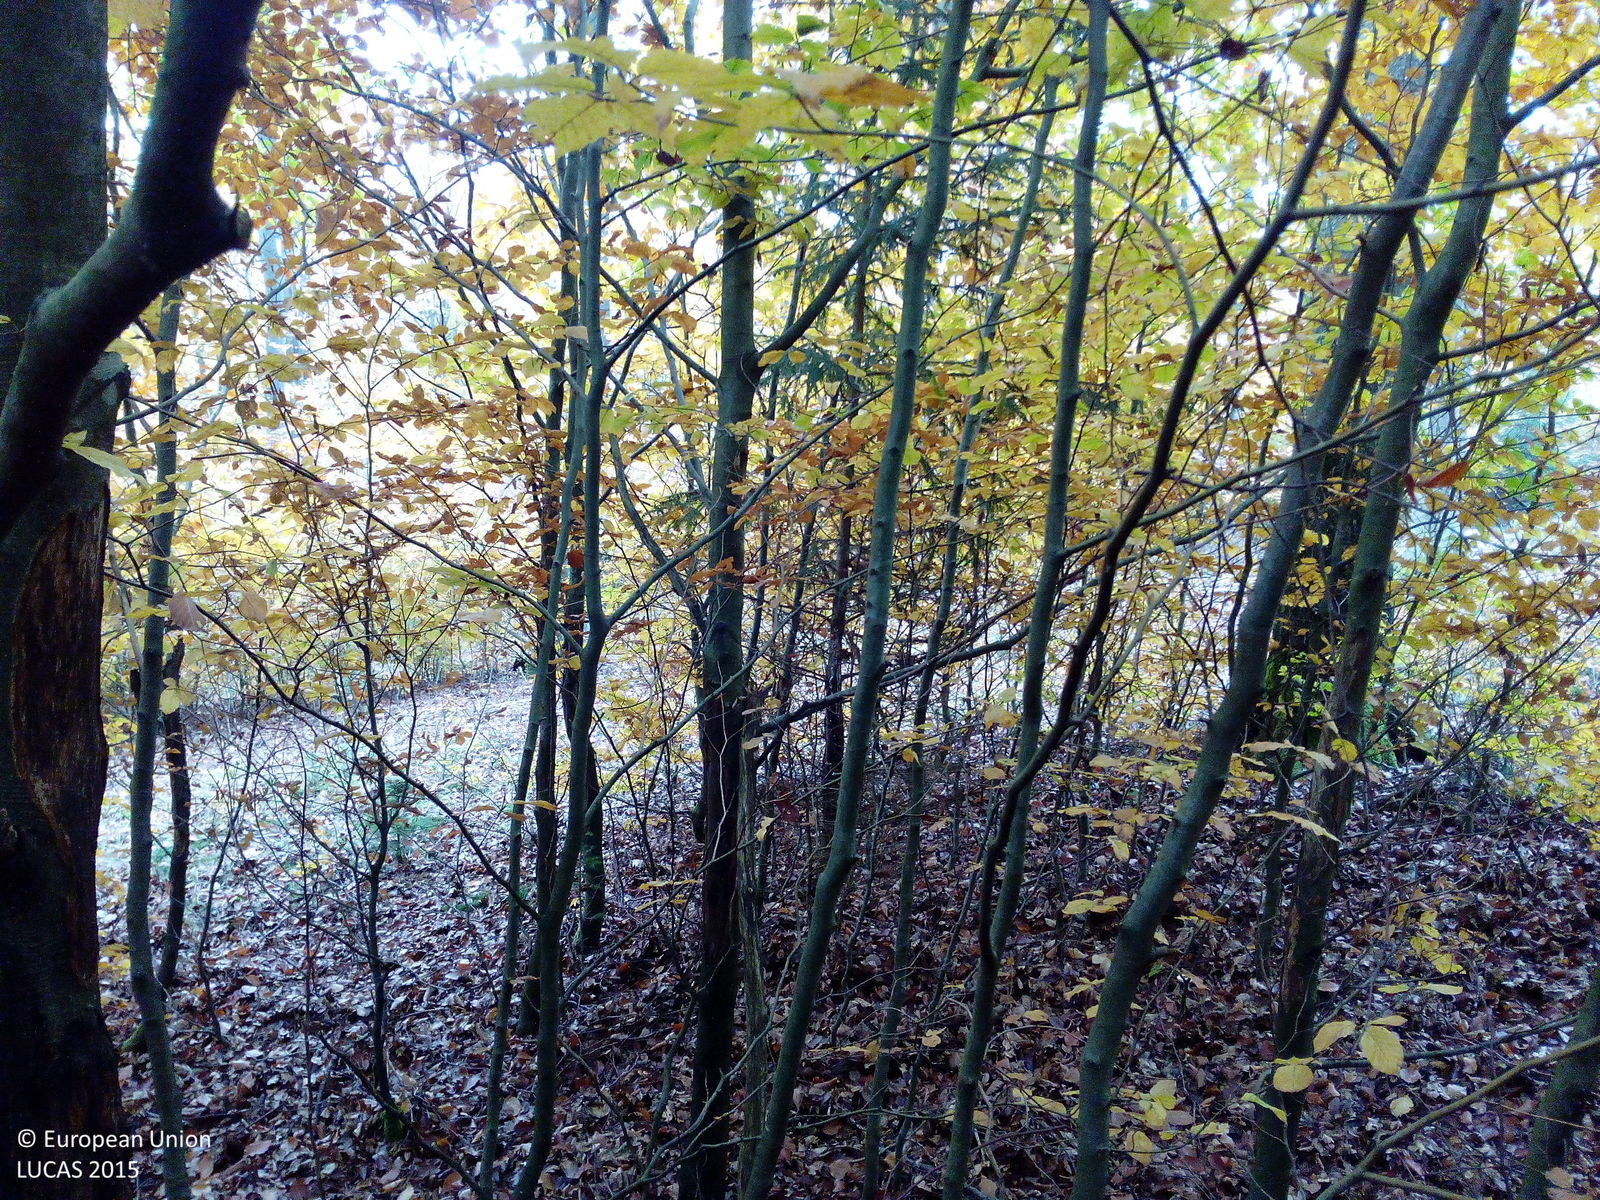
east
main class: Woodland
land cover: Broadleaved woodland
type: mesophytic deciduous forest
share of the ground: > 75 %
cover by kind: broadleaved forest trees 70 %, unconsolidated bare surface 15 %, coniferous forest trees 10 %, lichens and mosses 5 %
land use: Forestry
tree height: > 5 m
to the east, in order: Broadleaved woodland; Tracks; Broadleaved woodland; Tracks; Broadleaved woodland; Ditches and canals; Grass margins; Tracks; Grassland with sparse tree/shrub cover; Spontaneously vegetated surfaces; Groves; Broadleaved woodland; Grassland without tree/shrub cover; Spruce dominated coniferous woodland
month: October
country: DE
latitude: 50.2561
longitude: 9.9019
